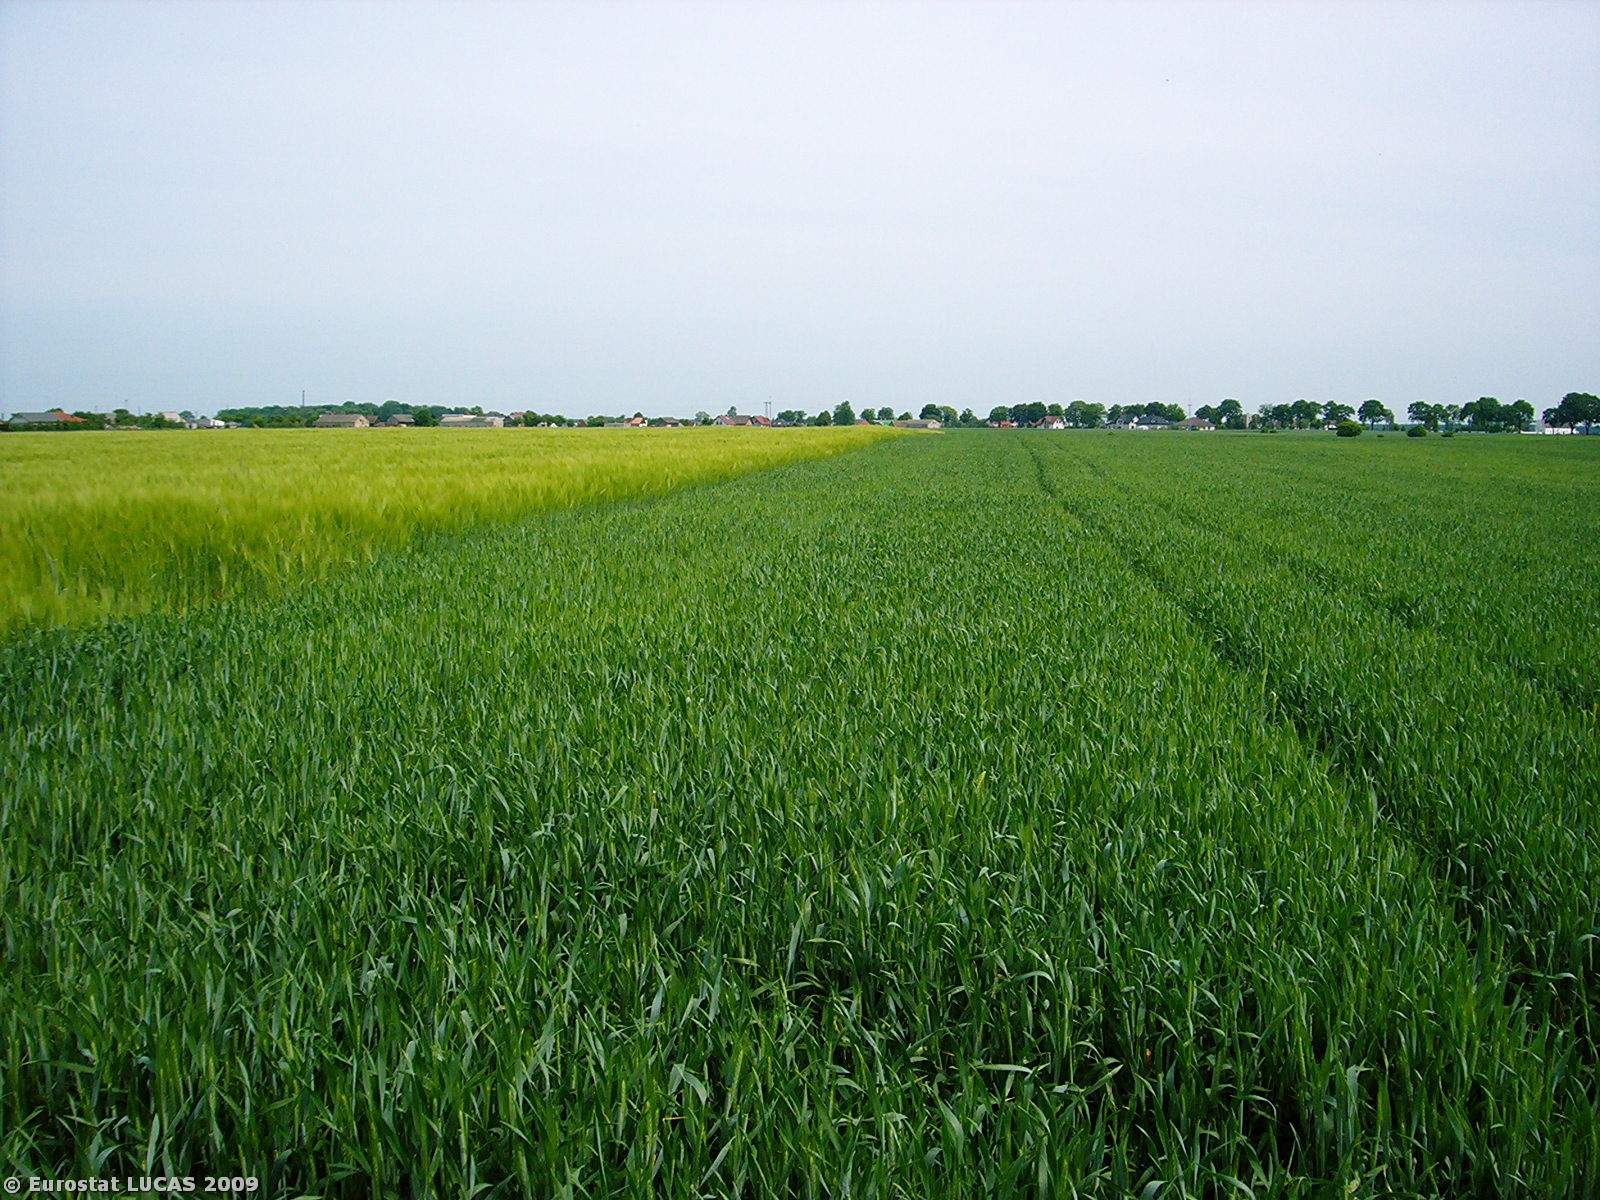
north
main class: Cropland
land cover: Triticale
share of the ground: > 75 %
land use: Agriculture (excluding fallow land and kitchen gardens)
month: May
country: PL
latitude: 52.6747
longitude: 16.3812
